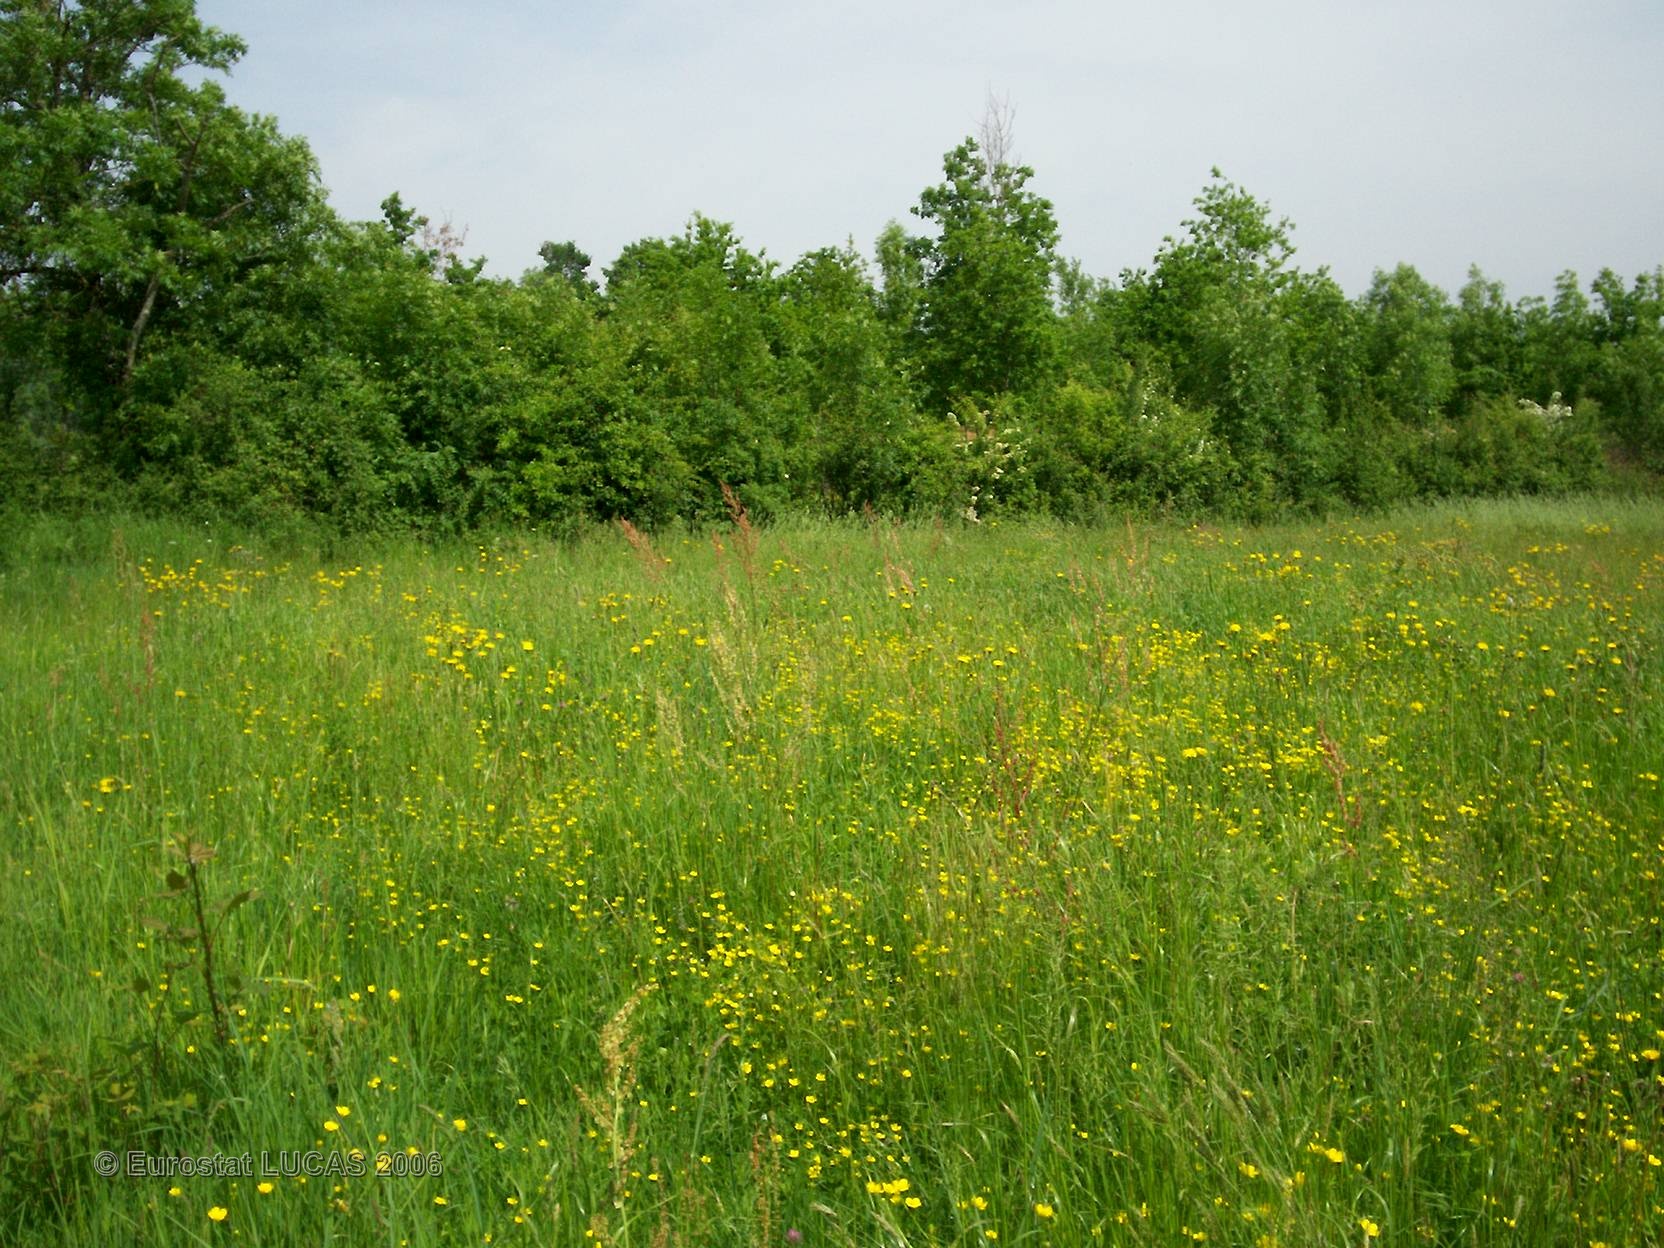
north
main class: Grassland
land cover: Grassland without tree/shrub cover
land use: Agriculture (excluding fallow land and kitchen gardens)
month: May
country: FR
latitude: 46.5232
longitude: -0.3100
